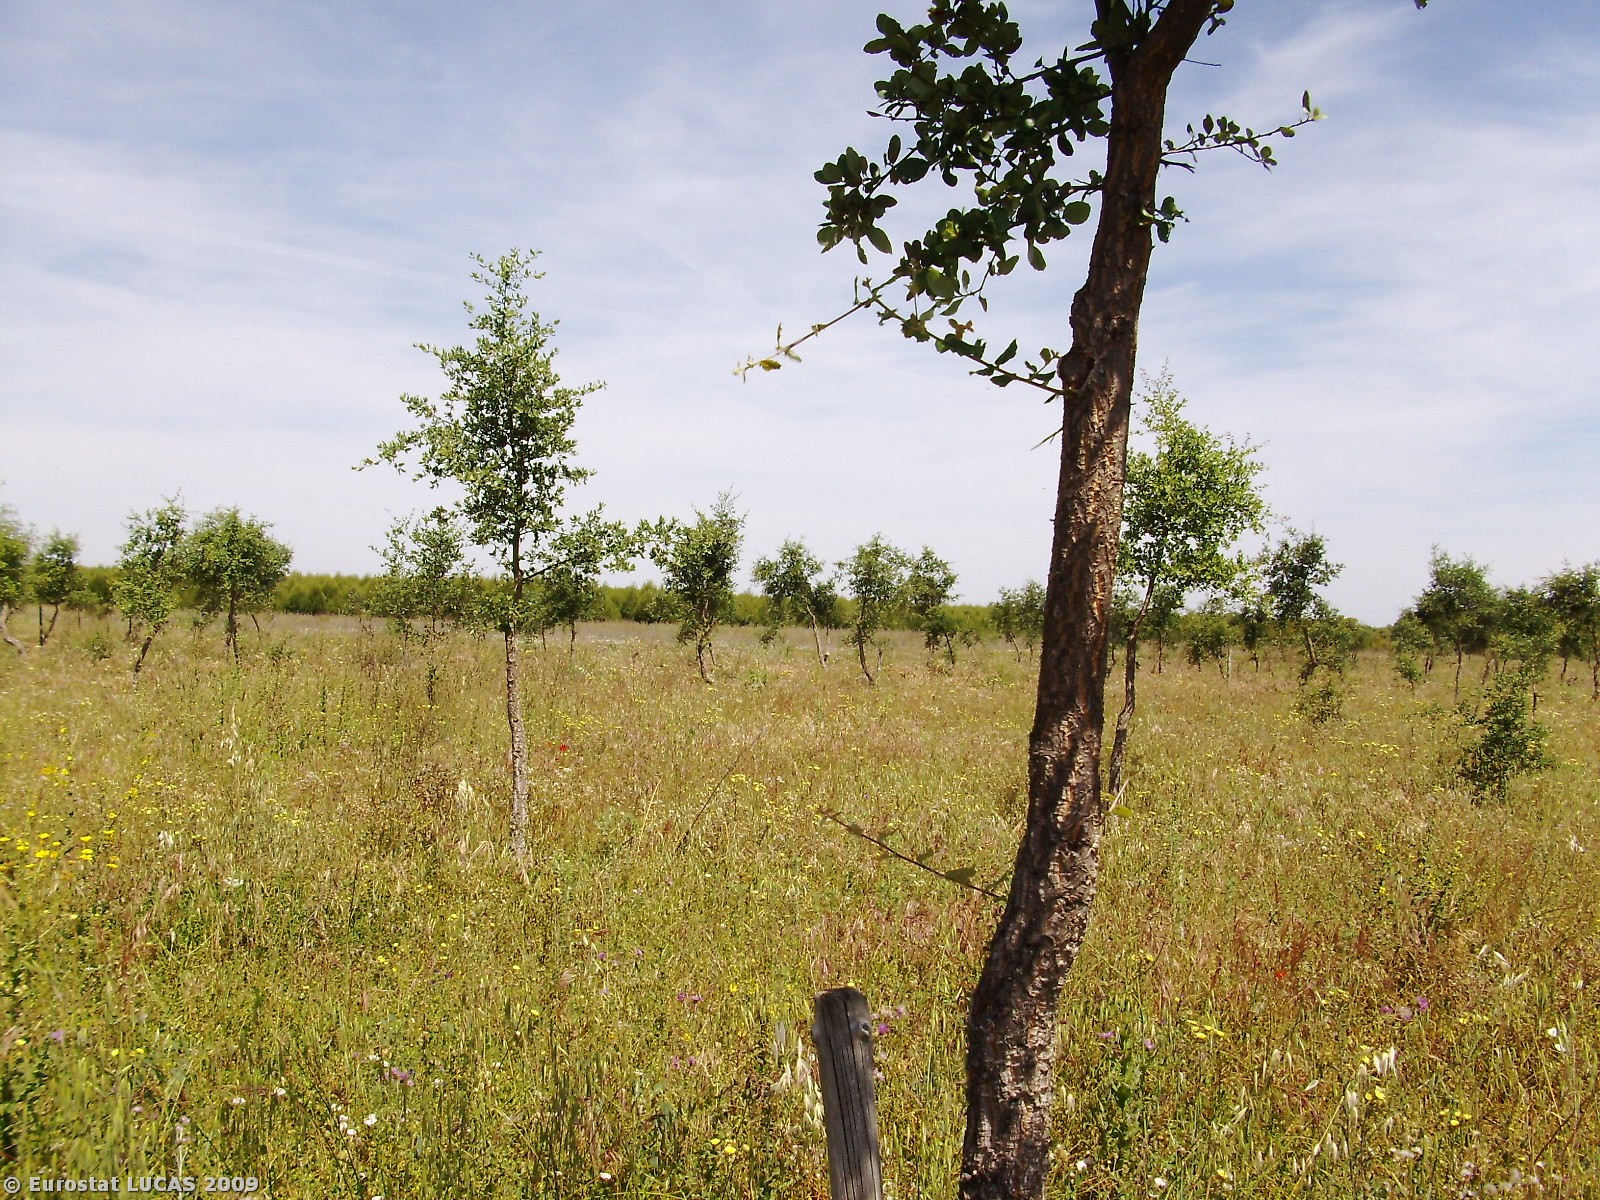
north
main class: Woodland
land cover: Broadleaved woodland
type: broadleaved evergreen forest
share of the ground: 25 - 50 %
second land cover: Spontaneously vegetated surfaces
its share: 50 - 75 %
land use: Forestry
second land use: Fallow land
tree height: > 5 m
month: May
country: PT
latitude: 39.0372
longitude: -8.0629
